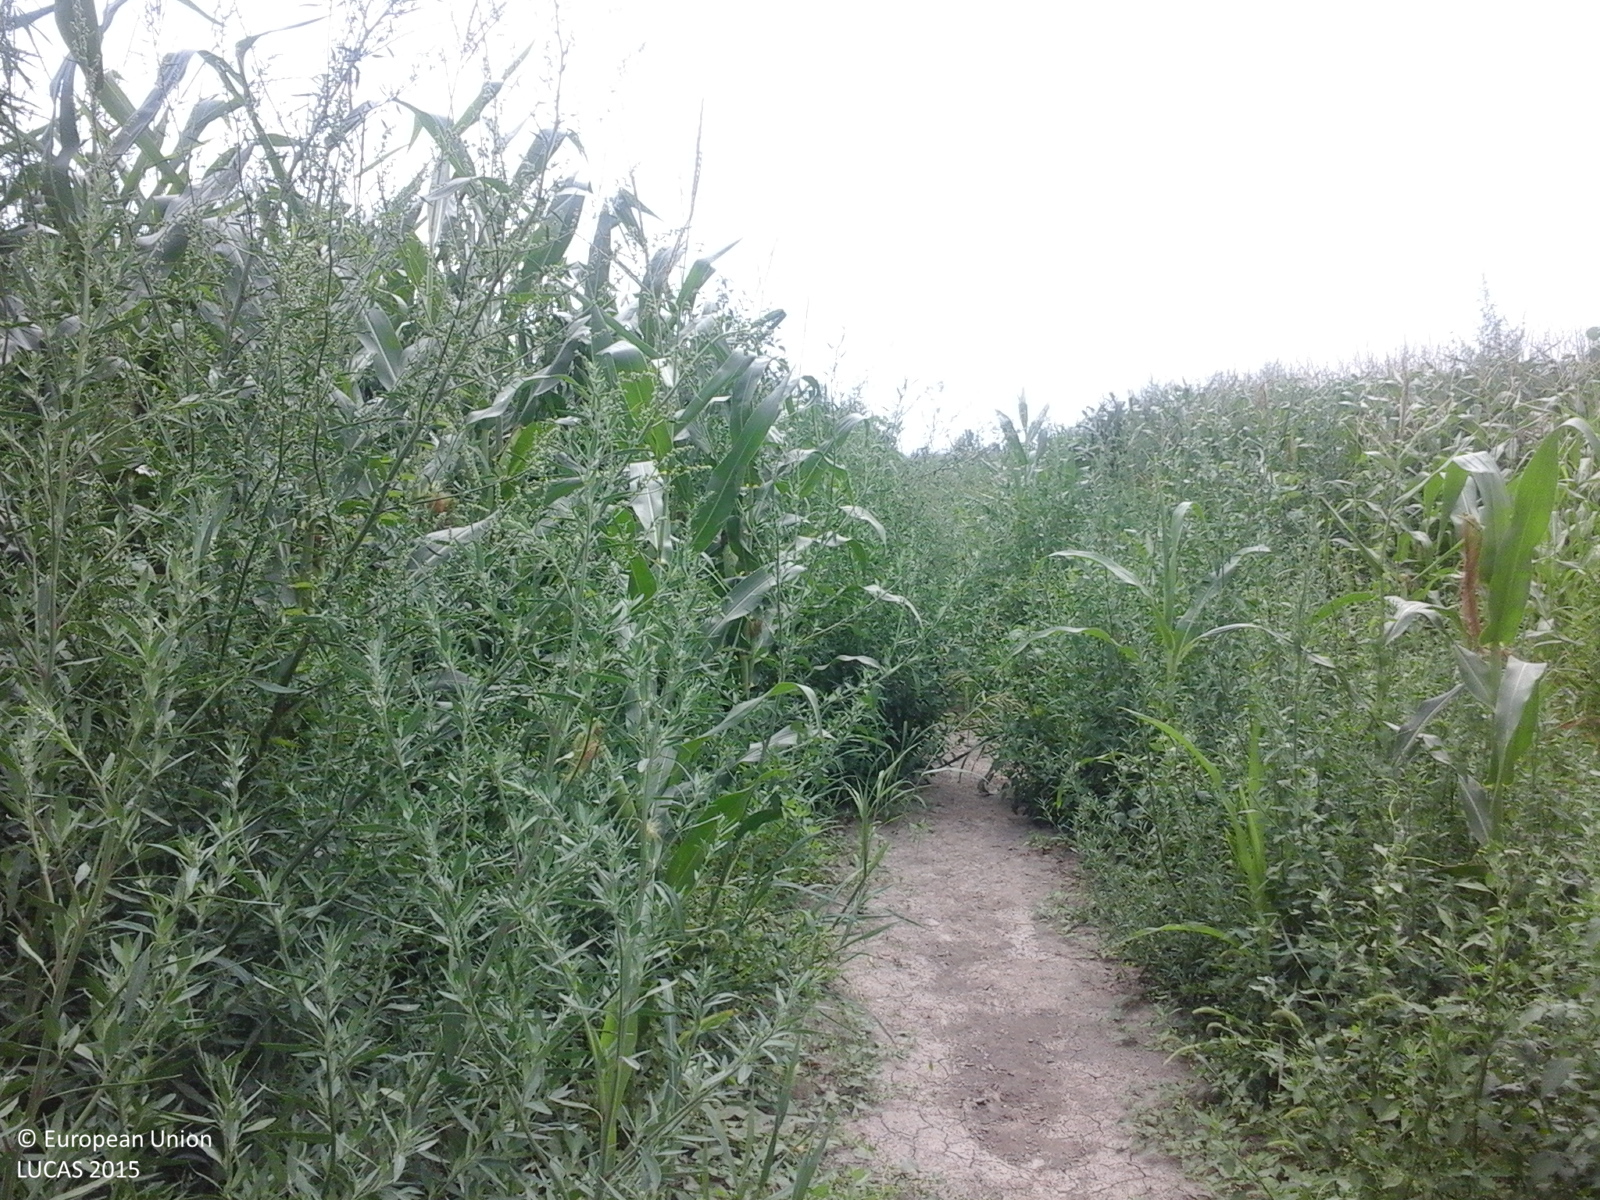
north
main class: Cropland
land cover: Maize
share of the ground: > 75 %
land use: Agriculture (excluding fallow land and kitchen gardens)
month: August
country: RO
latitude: 45.3218
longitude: 29.0447
